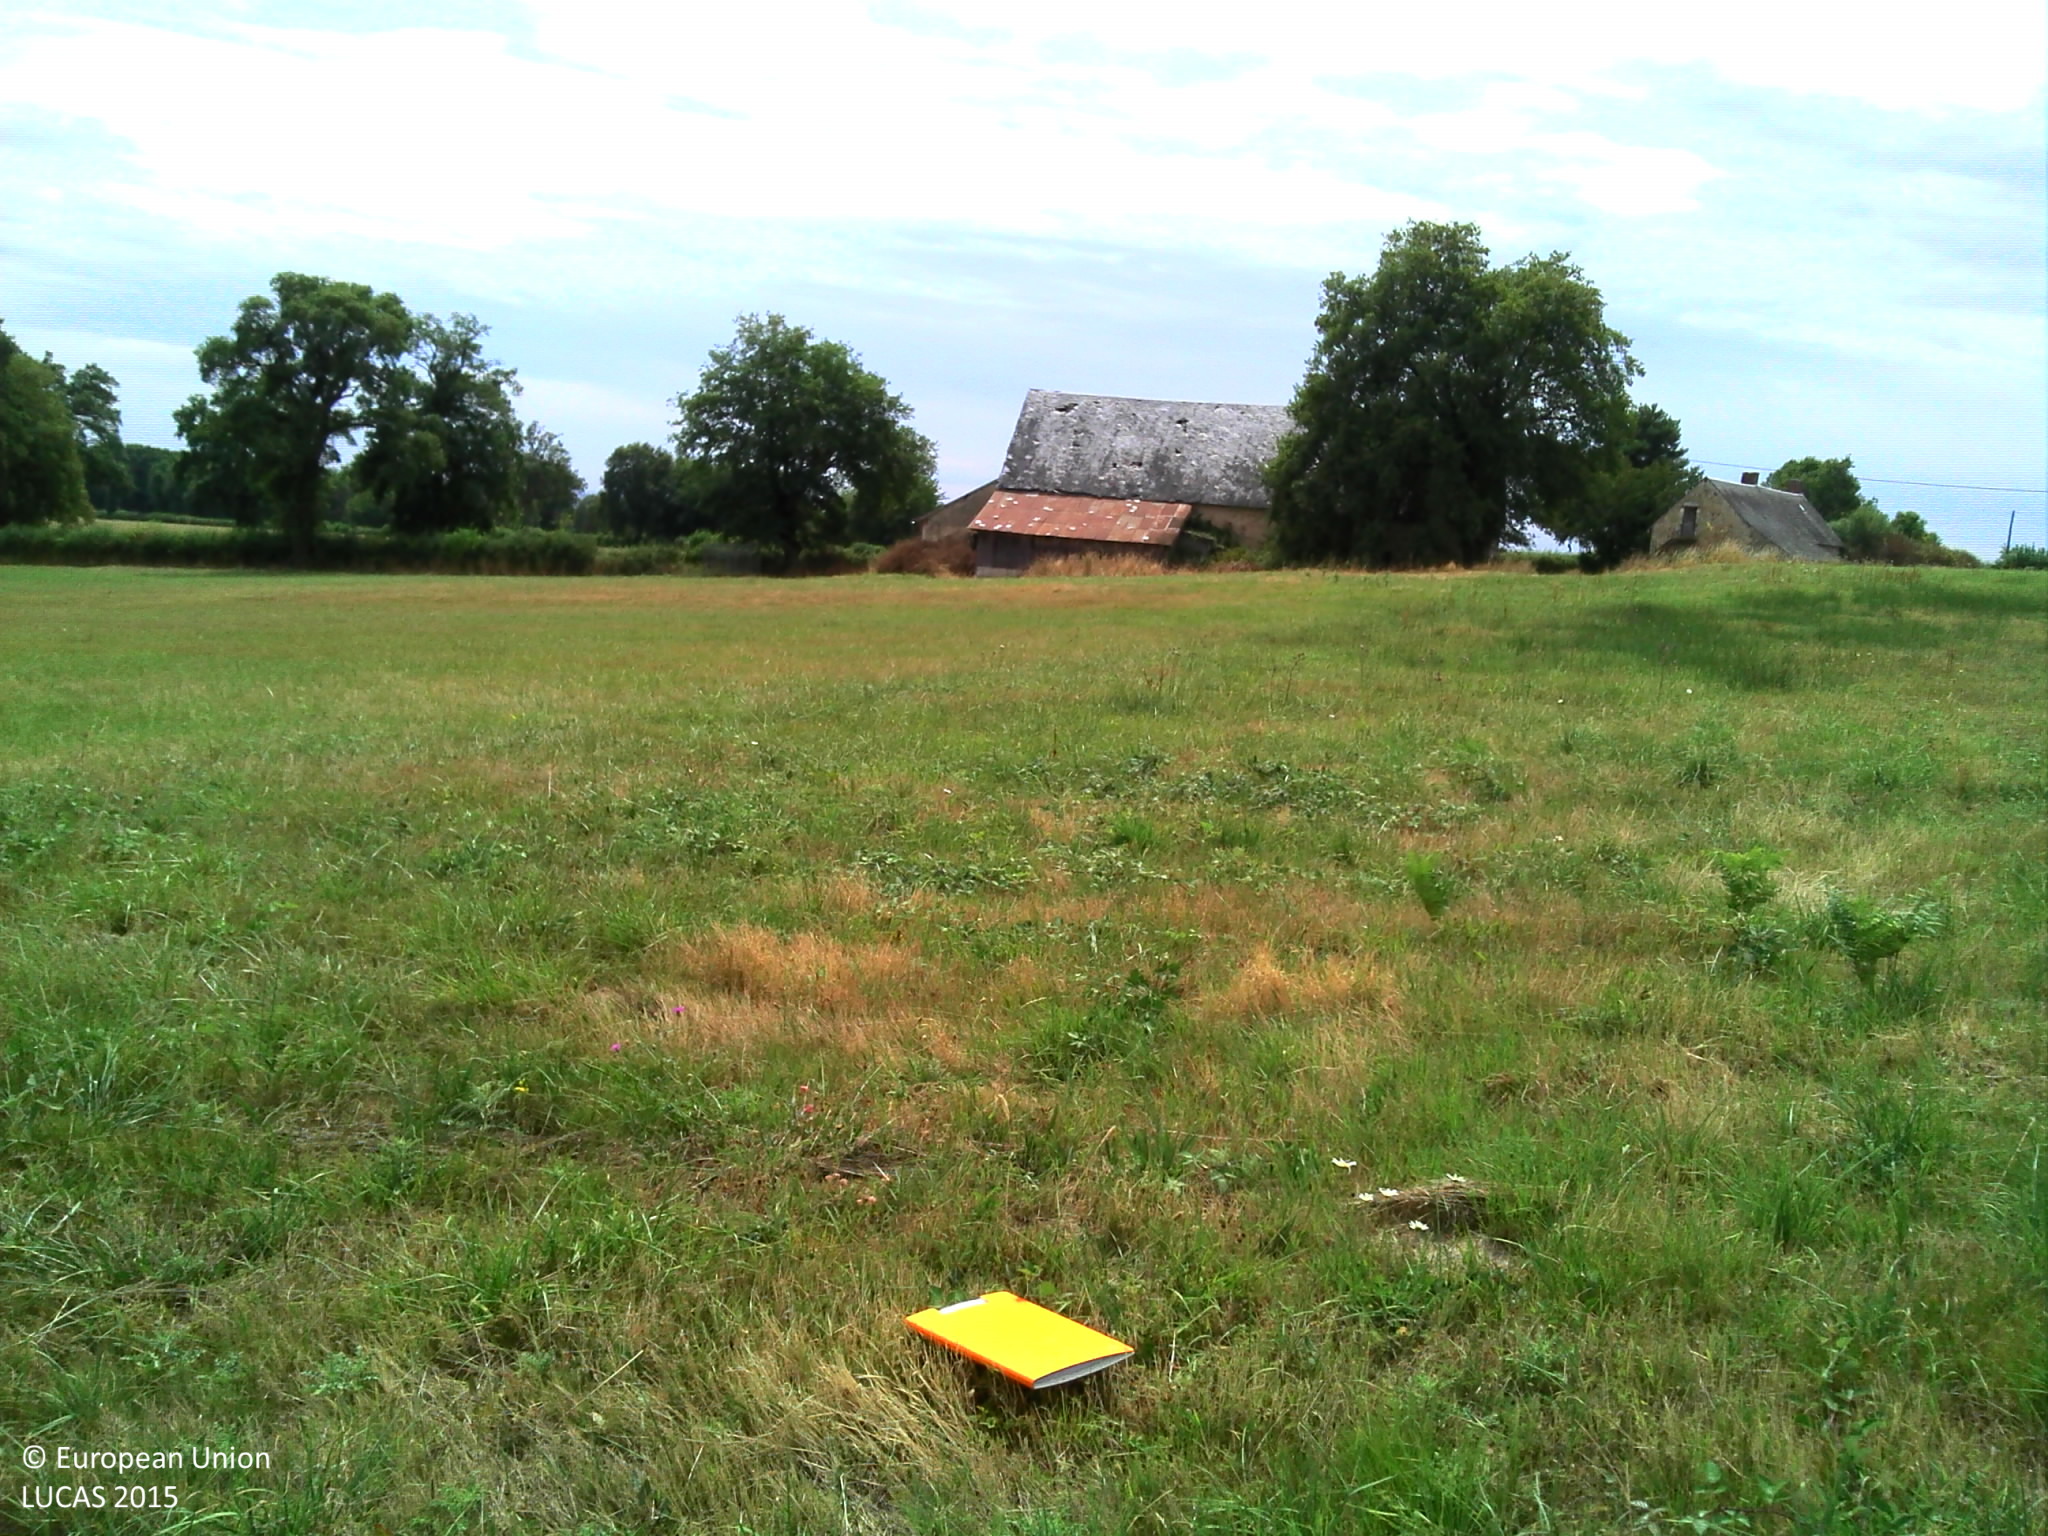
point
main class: Grassland
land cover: Grassland without tree/shrub cover
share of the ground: > 75 %
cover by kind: herbaceous plants 100 %
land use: Agriculture (excluding fallow land and kitchen gardens)
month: July
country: FR
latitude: 46.5575
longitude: 2.7566
